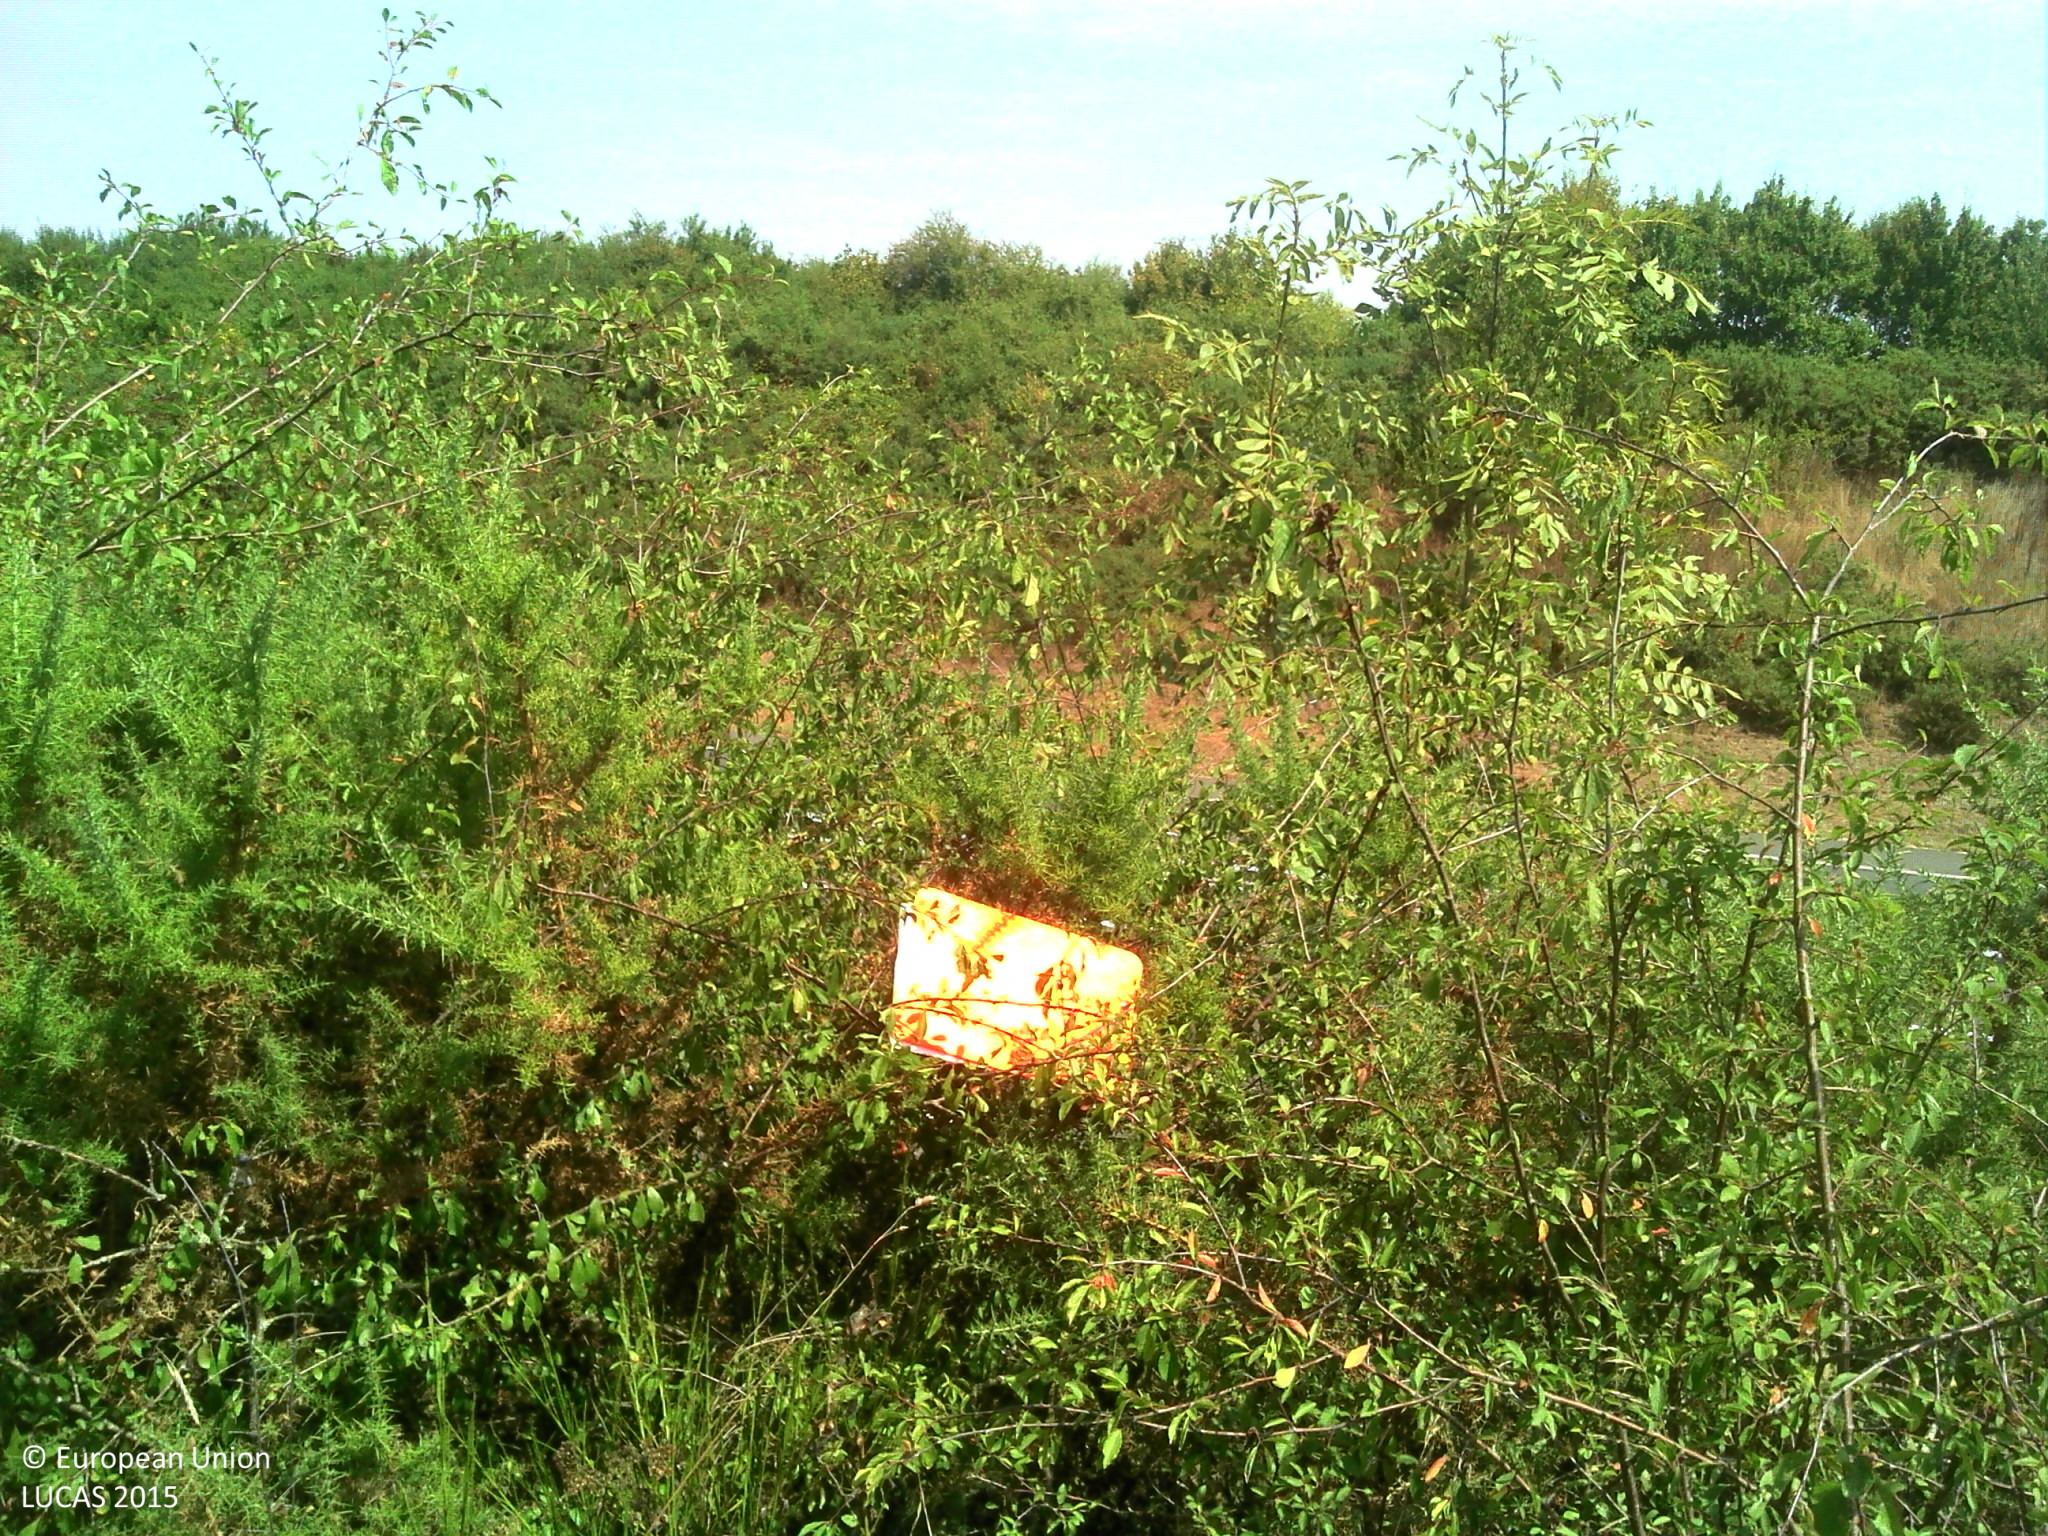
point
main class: Woodland
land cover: Broadleaved woodland
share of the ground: > 75 %
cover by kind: broadleaved forest trees 90 %, shrubs 10 %
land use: Road transport
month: August
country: FR
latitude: 46.6563
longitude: -1.1551
